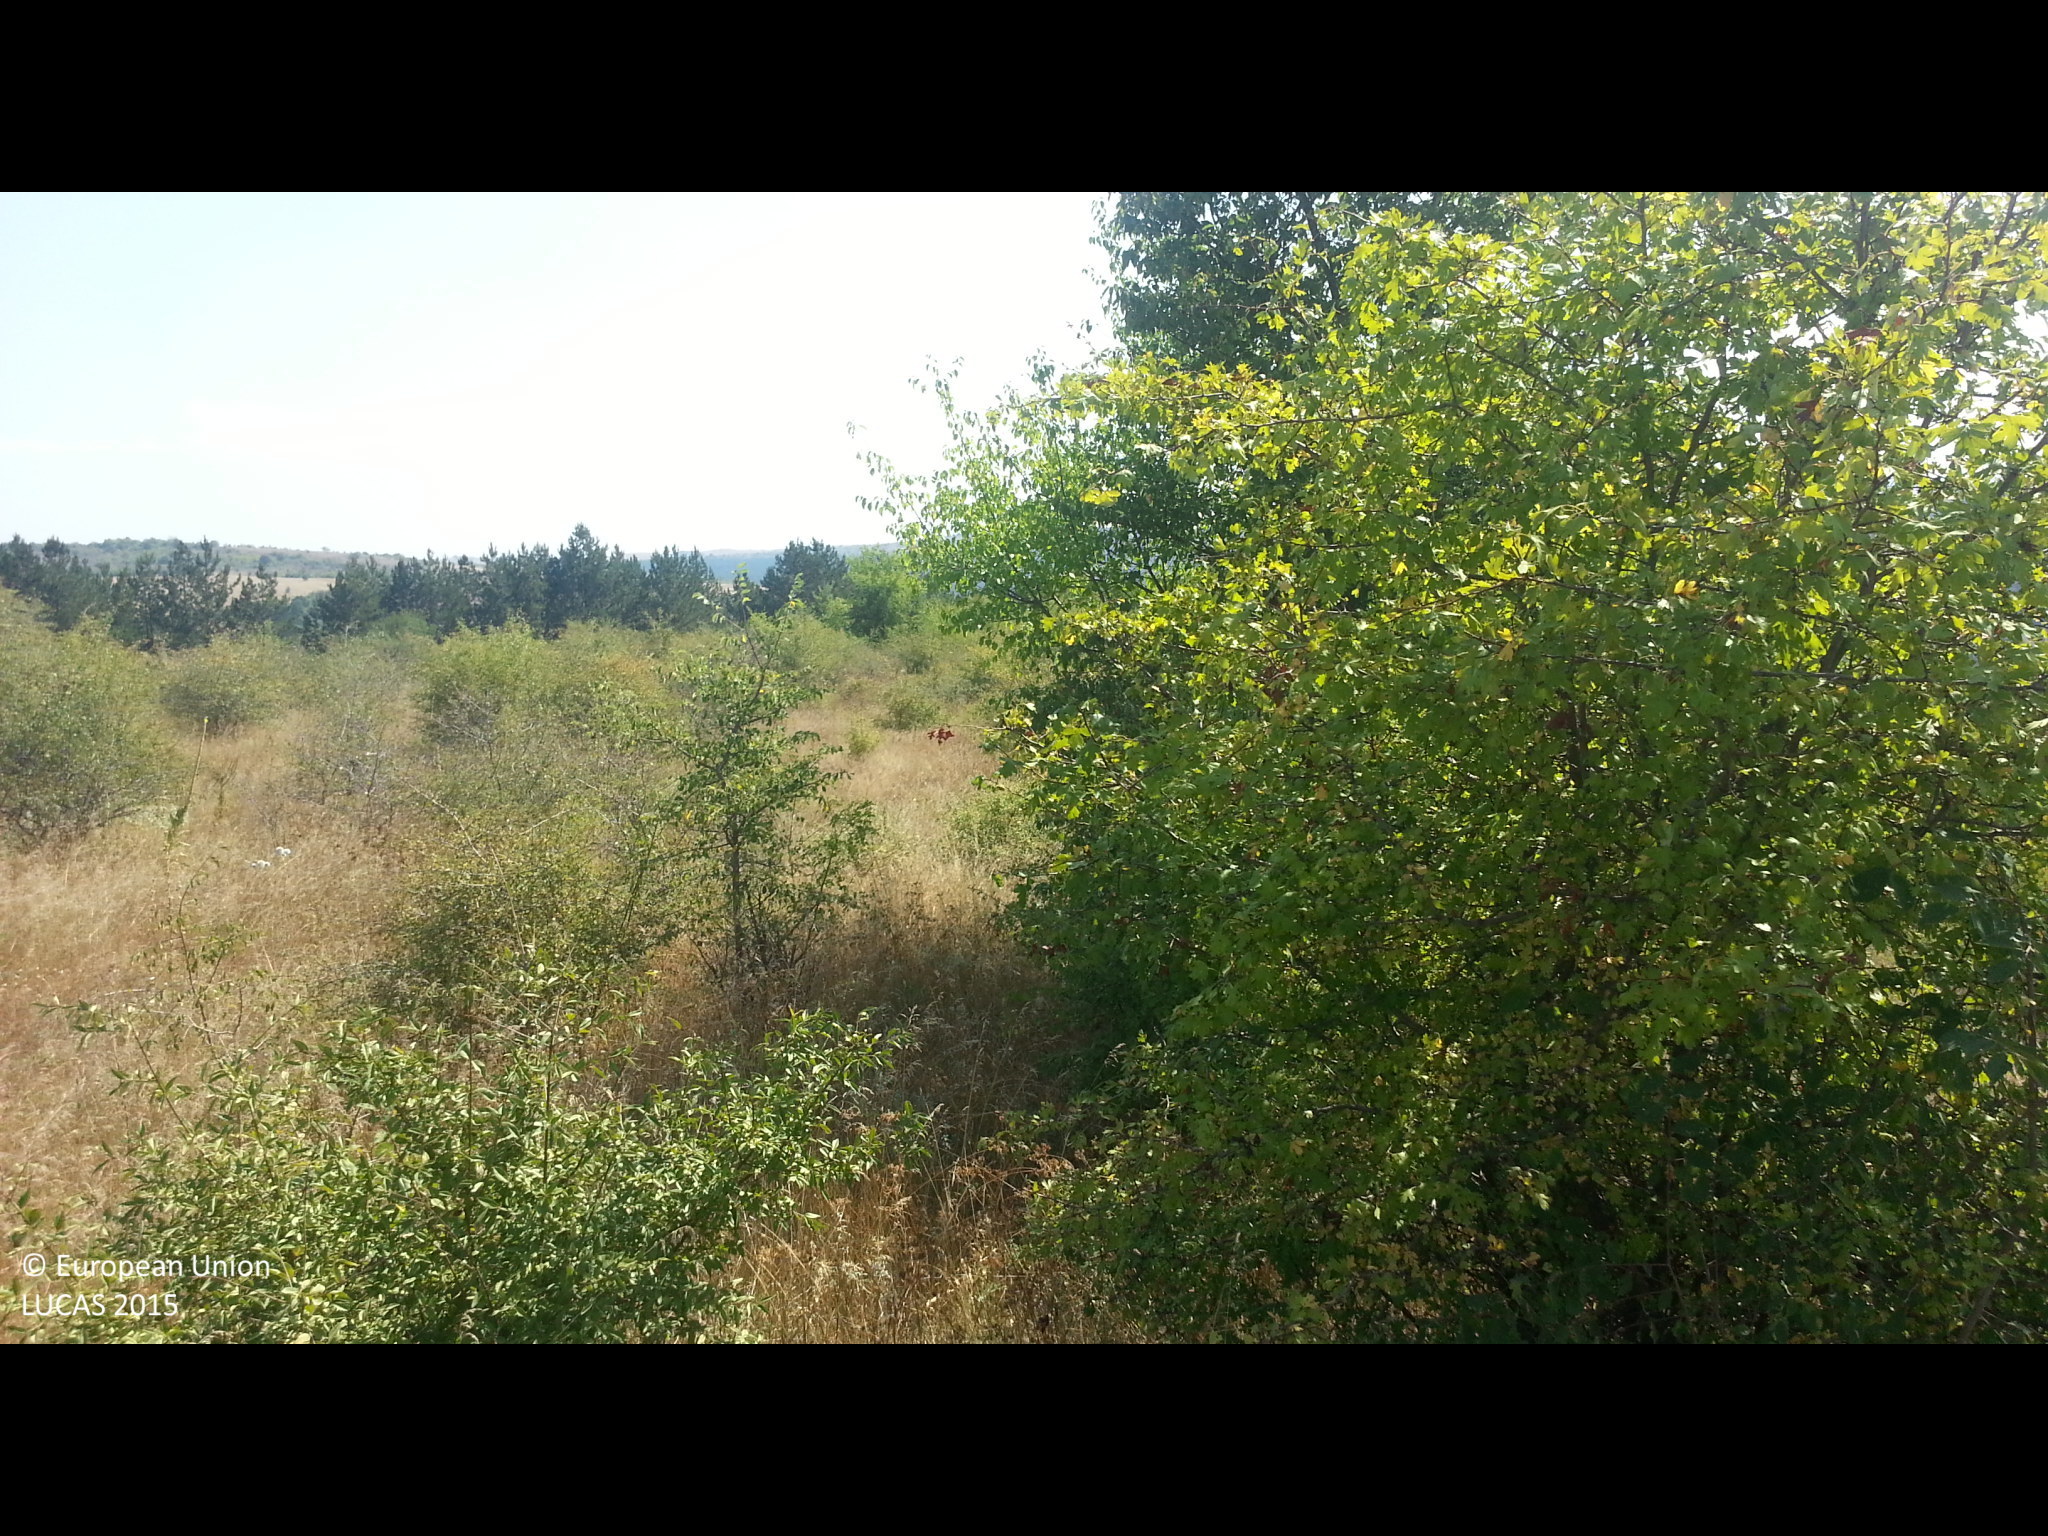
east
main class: Grassland
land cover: Grassland with sparse tree/shrub cover
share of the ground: > 75 %
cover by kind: herbaceous plants 85 %, shrubs 10 %, broadleaved forest trees 5 %
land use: Abandoned areas
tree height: < 5 m
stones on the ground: 10 - 25 %
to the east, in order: Grassland with sparse tree/shrub cover; Pine dominated coniferous woodland; Rocks and stones; Pine dominated coniferous woodland
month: August
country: BG
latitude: 42.2476
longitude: 22.8830
